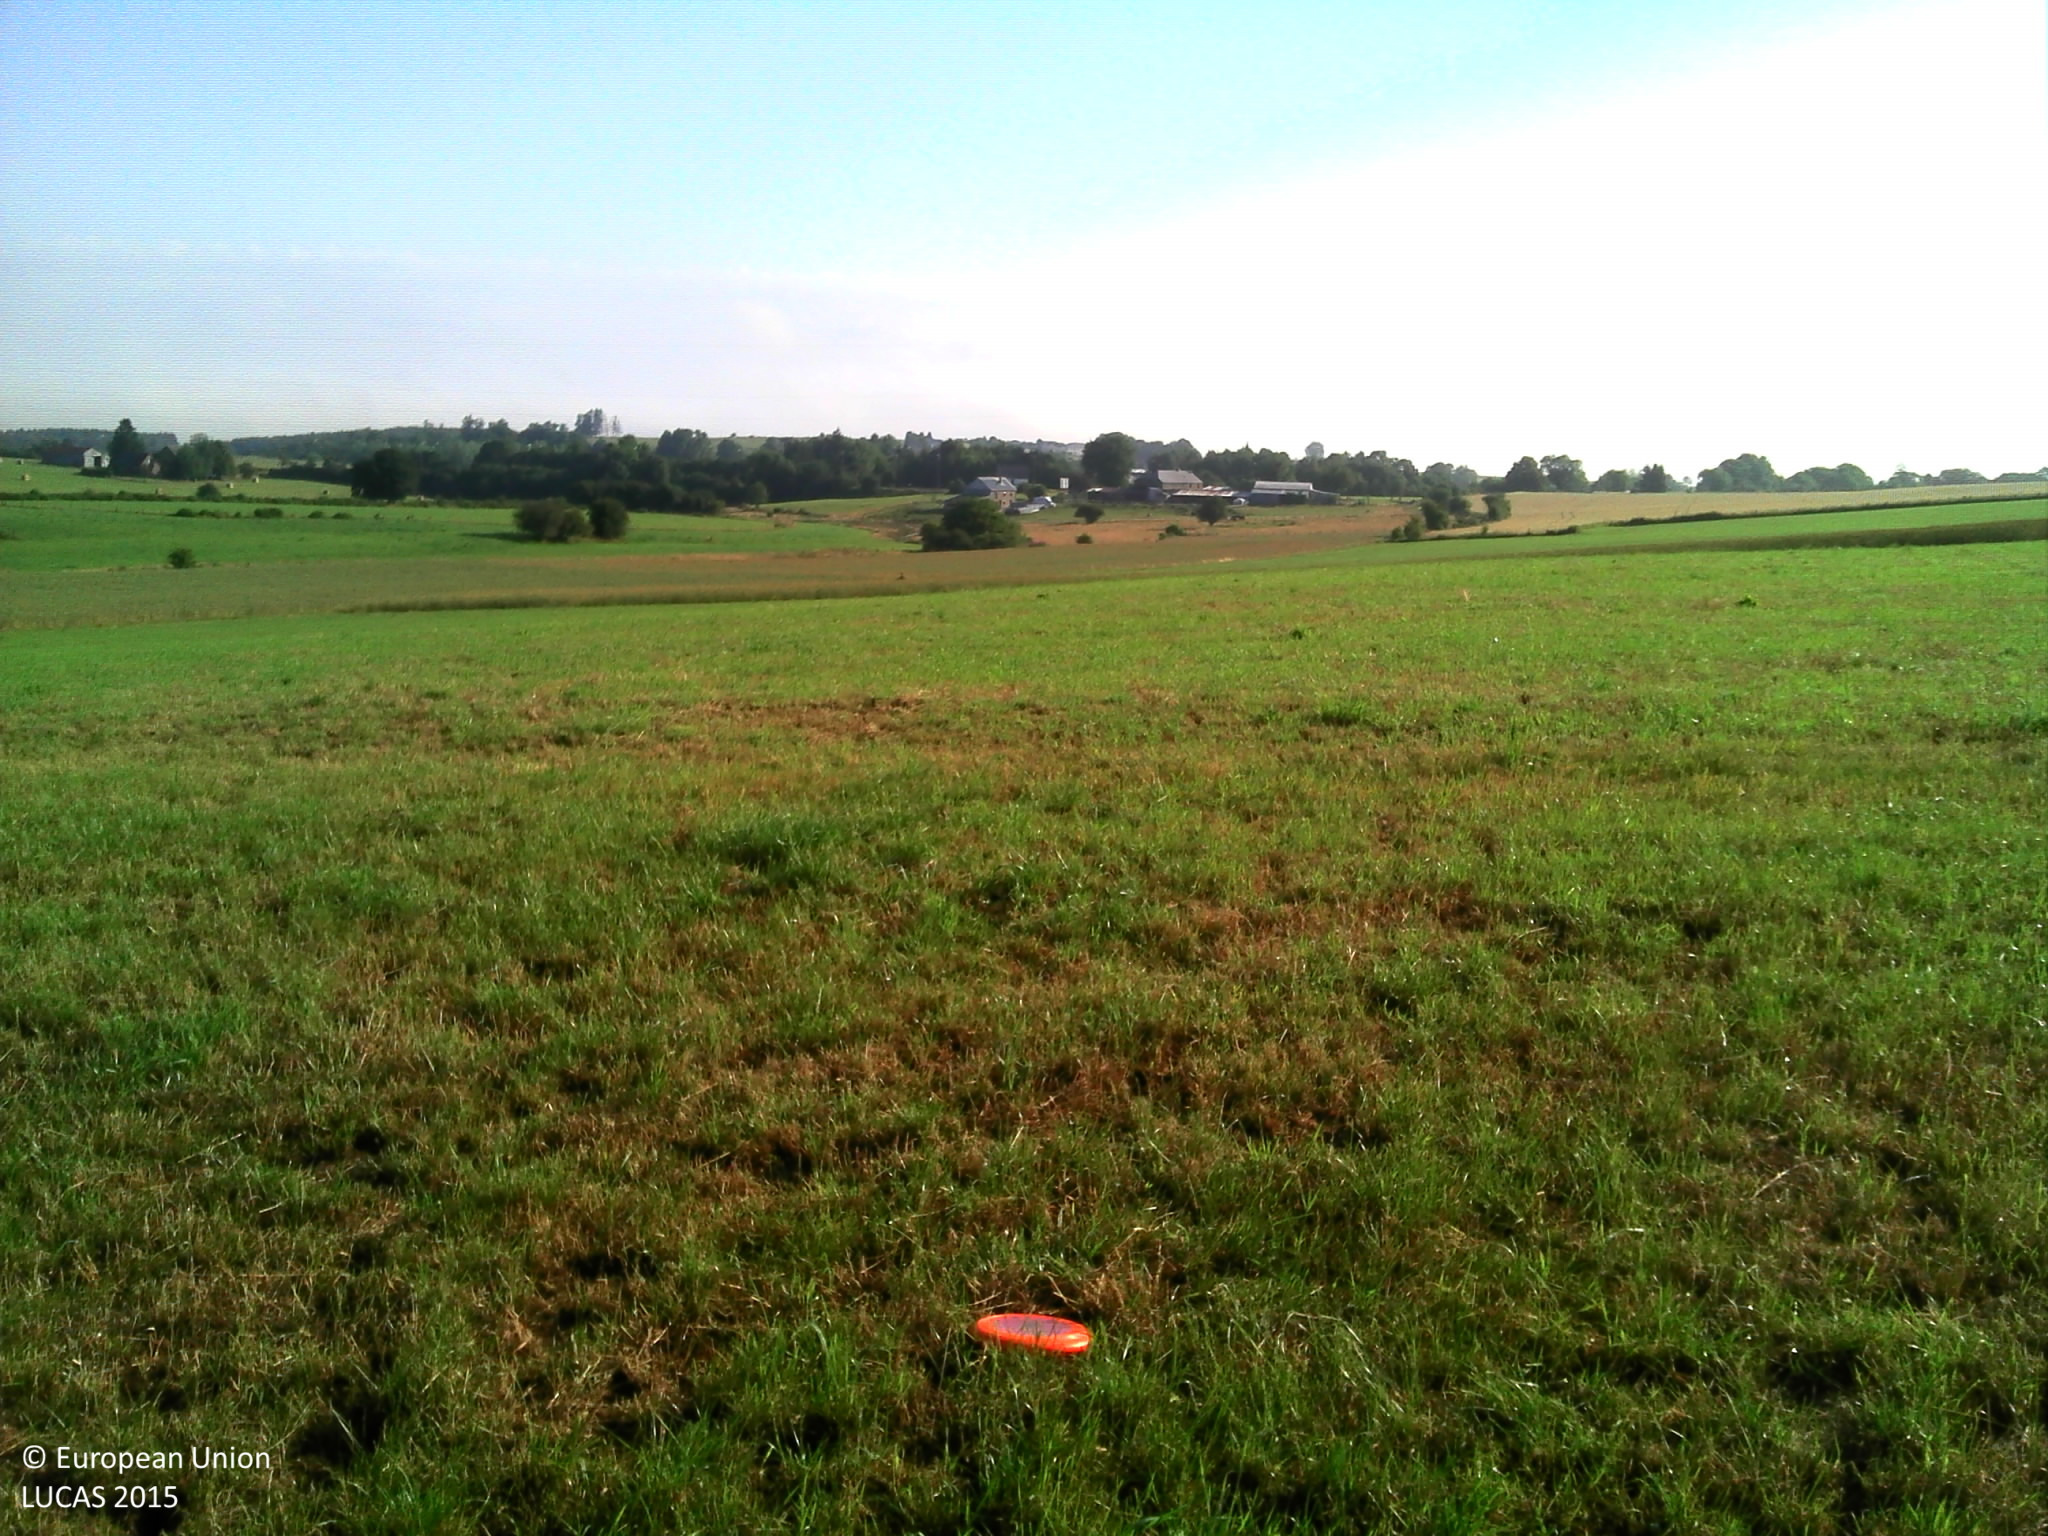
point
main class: Grassland
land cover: Grassland without tree/shrub cover
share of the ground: > 75 %
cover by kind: herbaceous plants 100 %
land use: Agriculture (excluding fallow land and kitchen gardens)
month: July
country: BE
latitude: 50.0105
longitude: 5.6309
